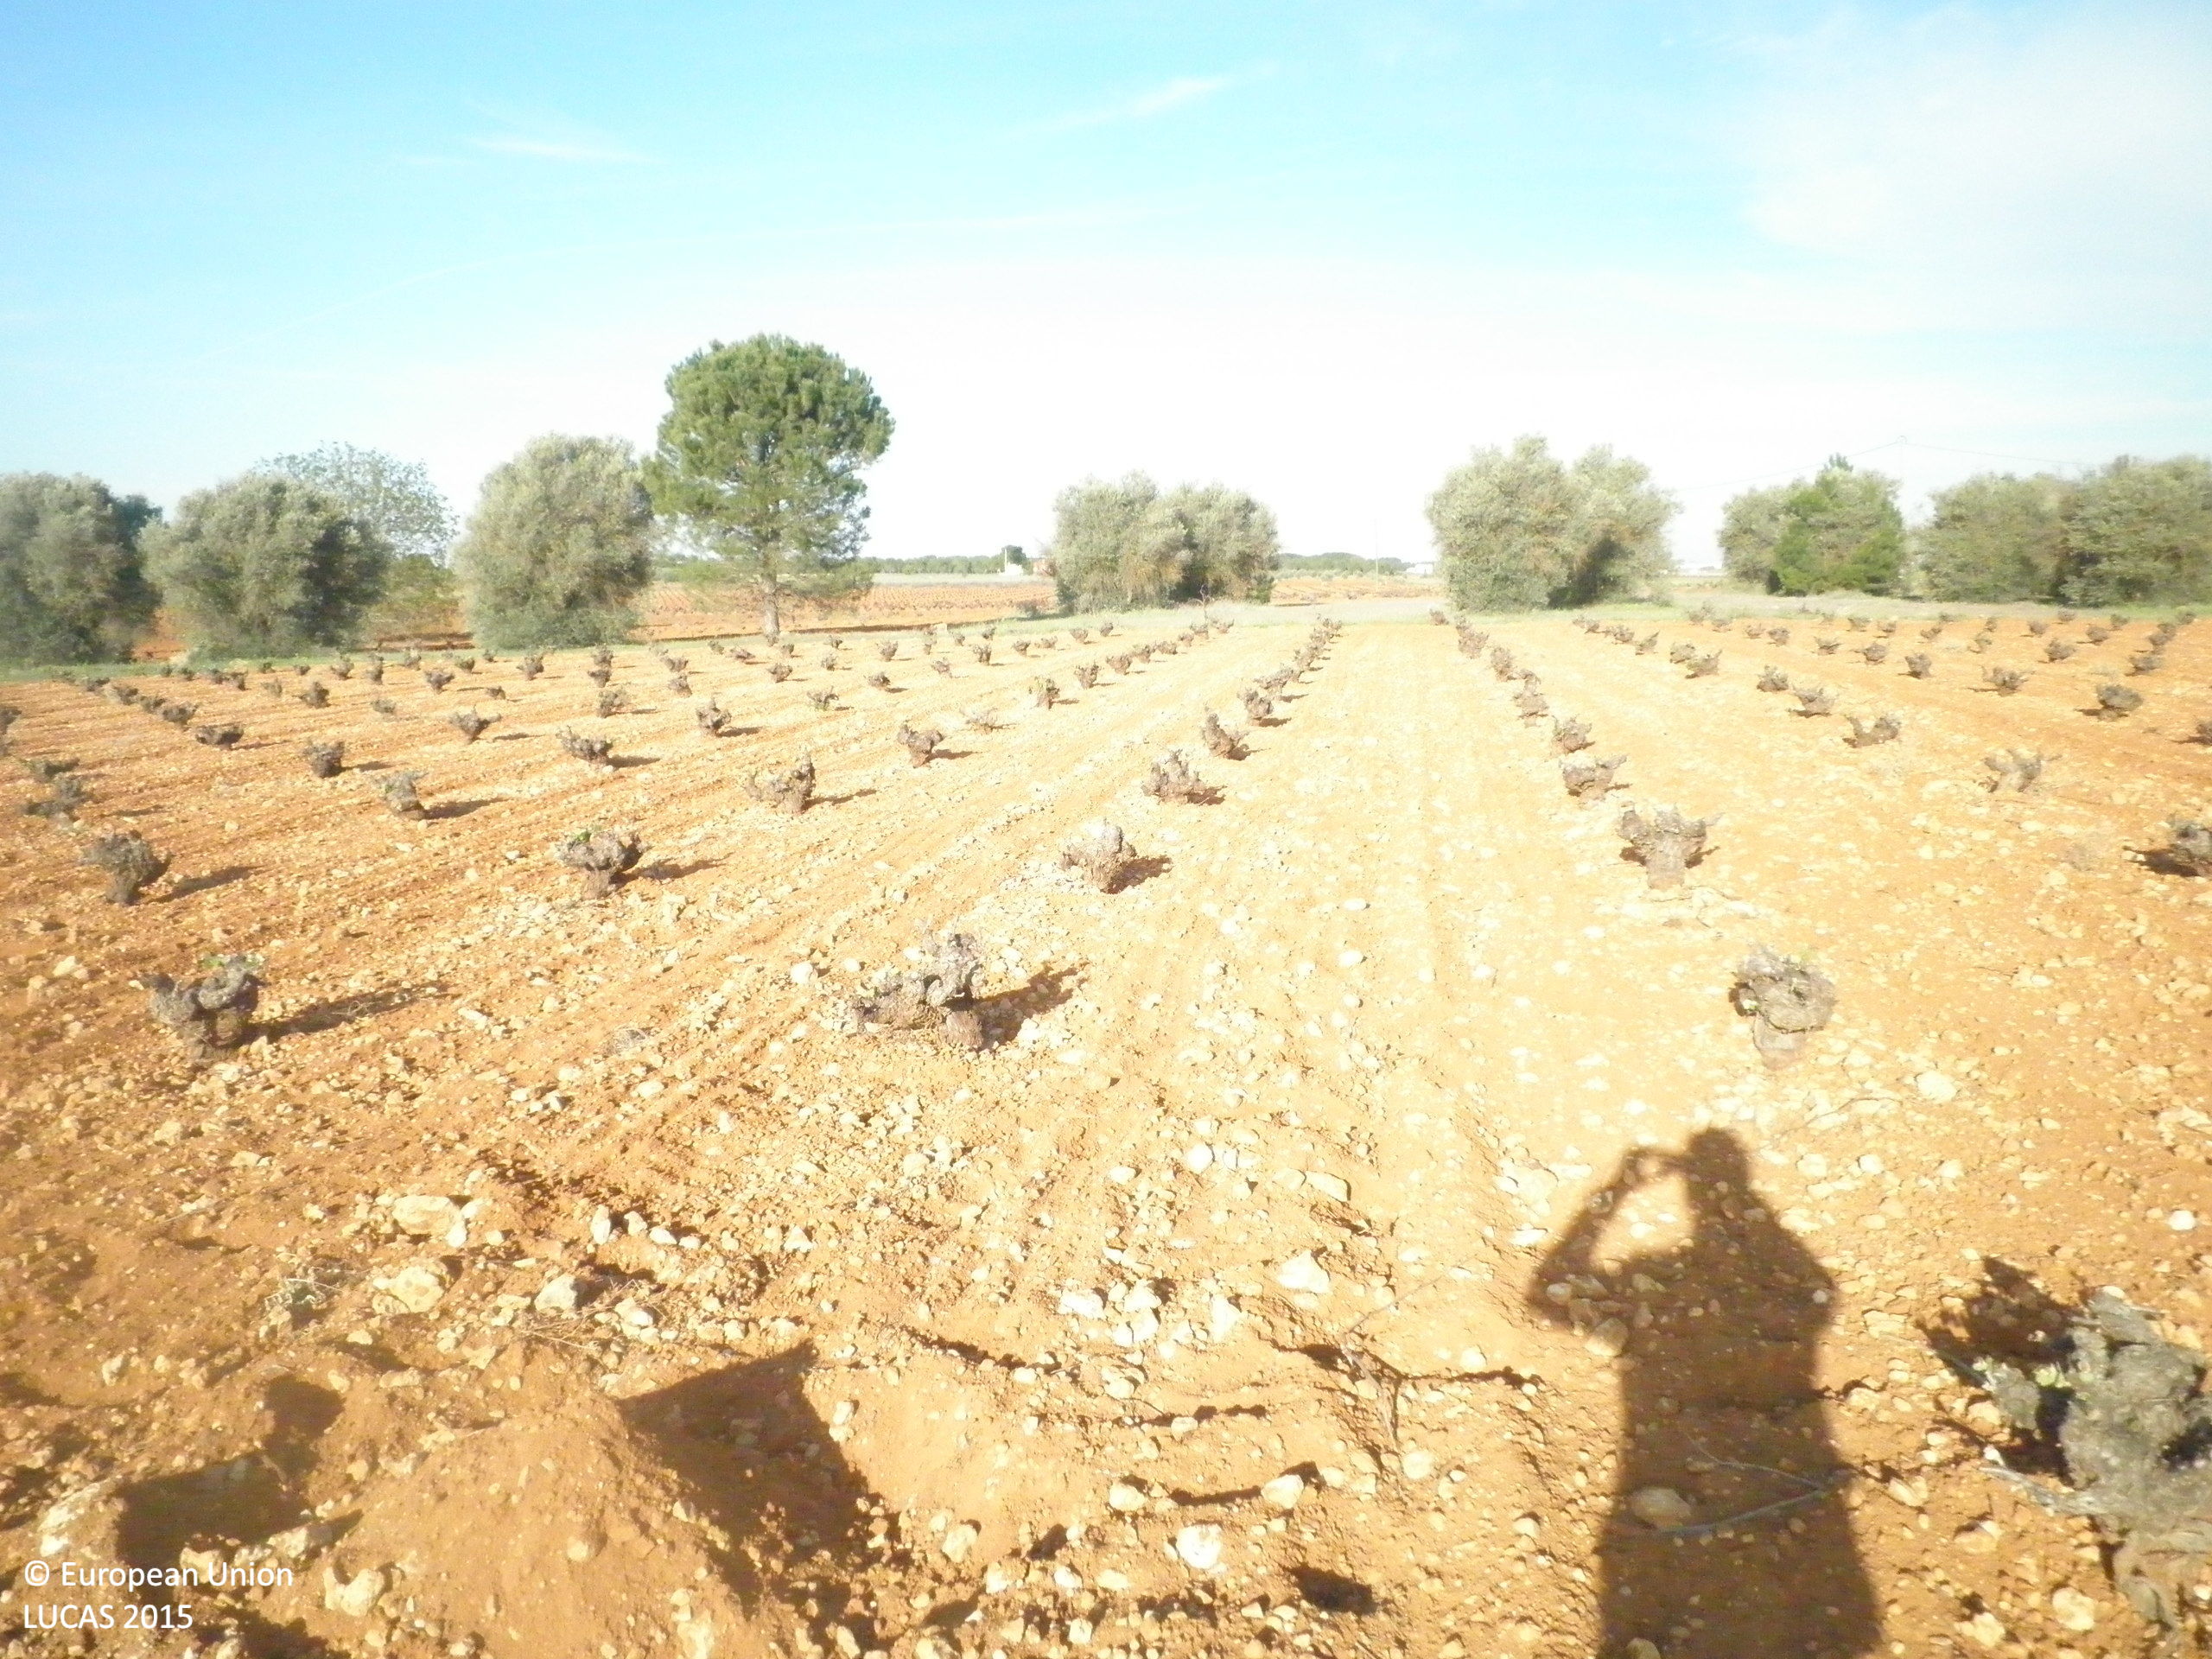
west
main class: Cropland
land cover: Vineyards
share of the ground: < 10 %
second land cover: Other bare soil
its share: > 75 %
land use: Agriculture (excluding fallow land and kitchen gardens)
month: April
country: ES
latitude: 39.3655
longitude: -2.5577
